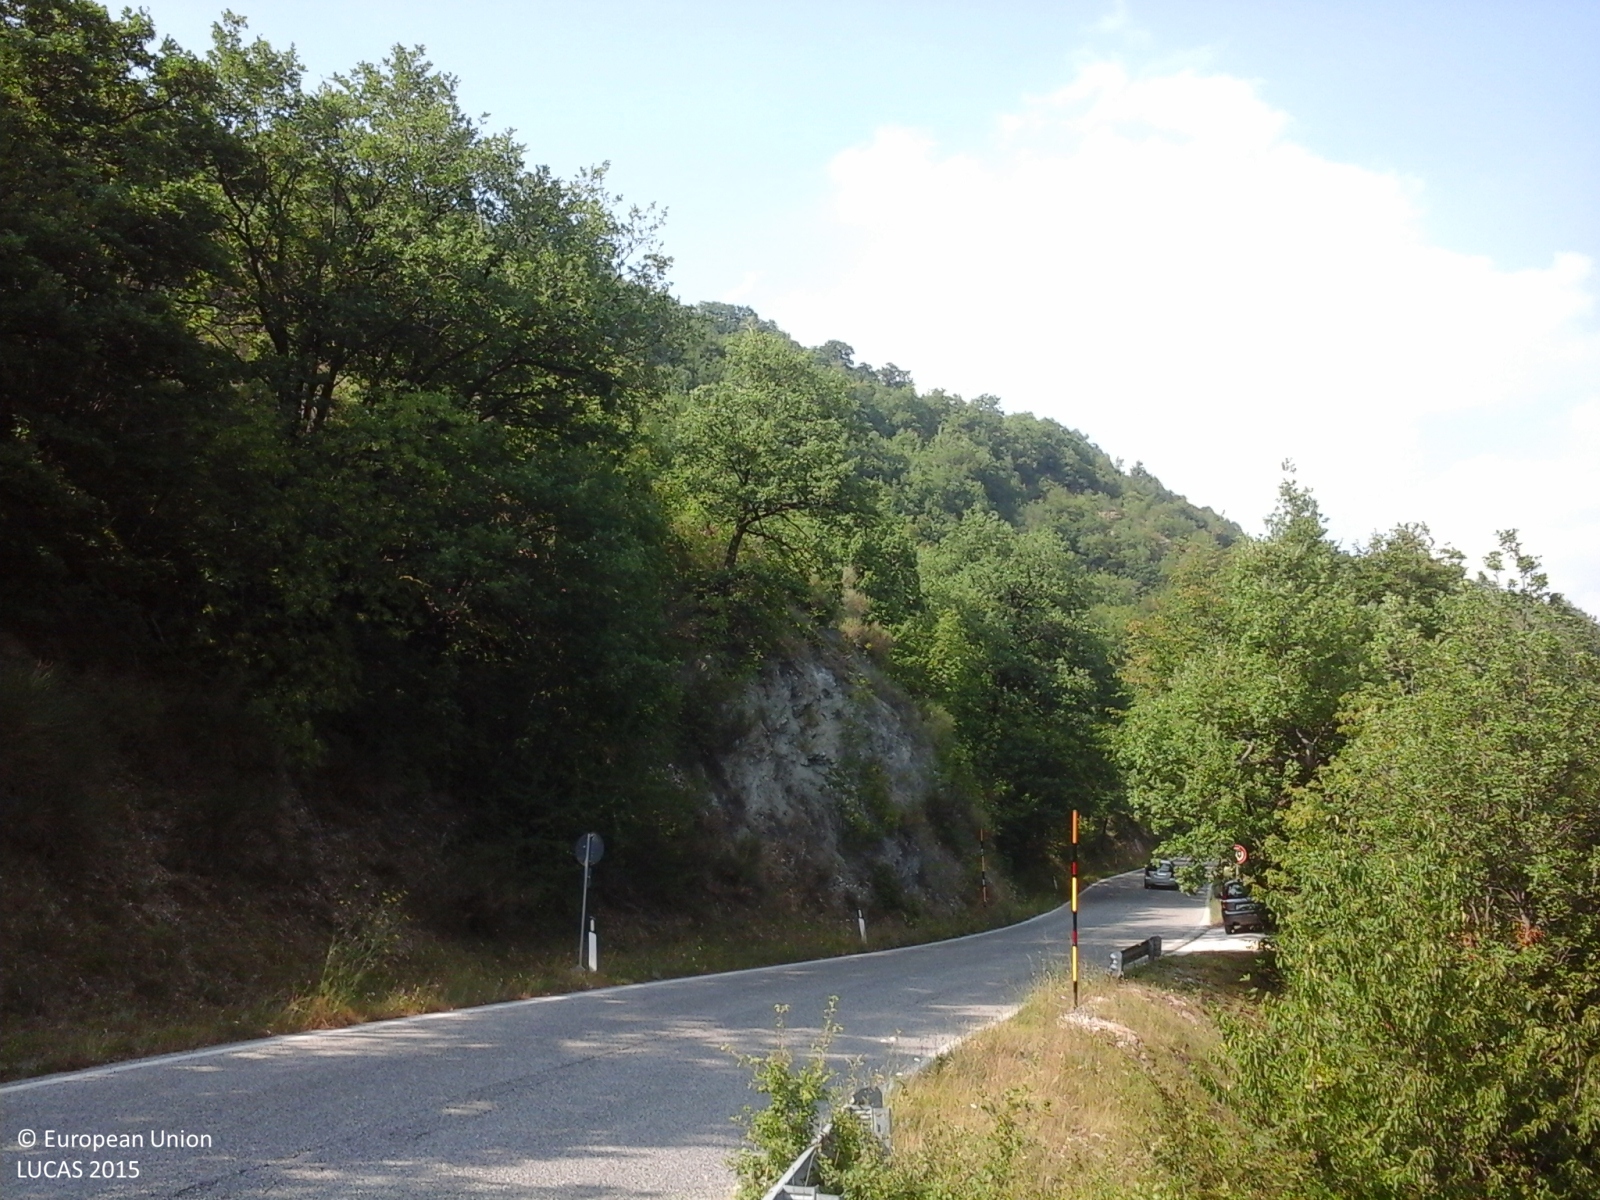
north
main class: Woodland
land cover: Broadleaved woodland
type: thermophilous deciduous forest
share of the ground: > 75 %
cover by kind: broadleaved forest trees 85 %, herbaceous plants 10 %, shrubs 5 %
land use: Forestry
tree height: > 5 m
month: August
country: IT
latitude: 43.0794
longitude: 13.0008
